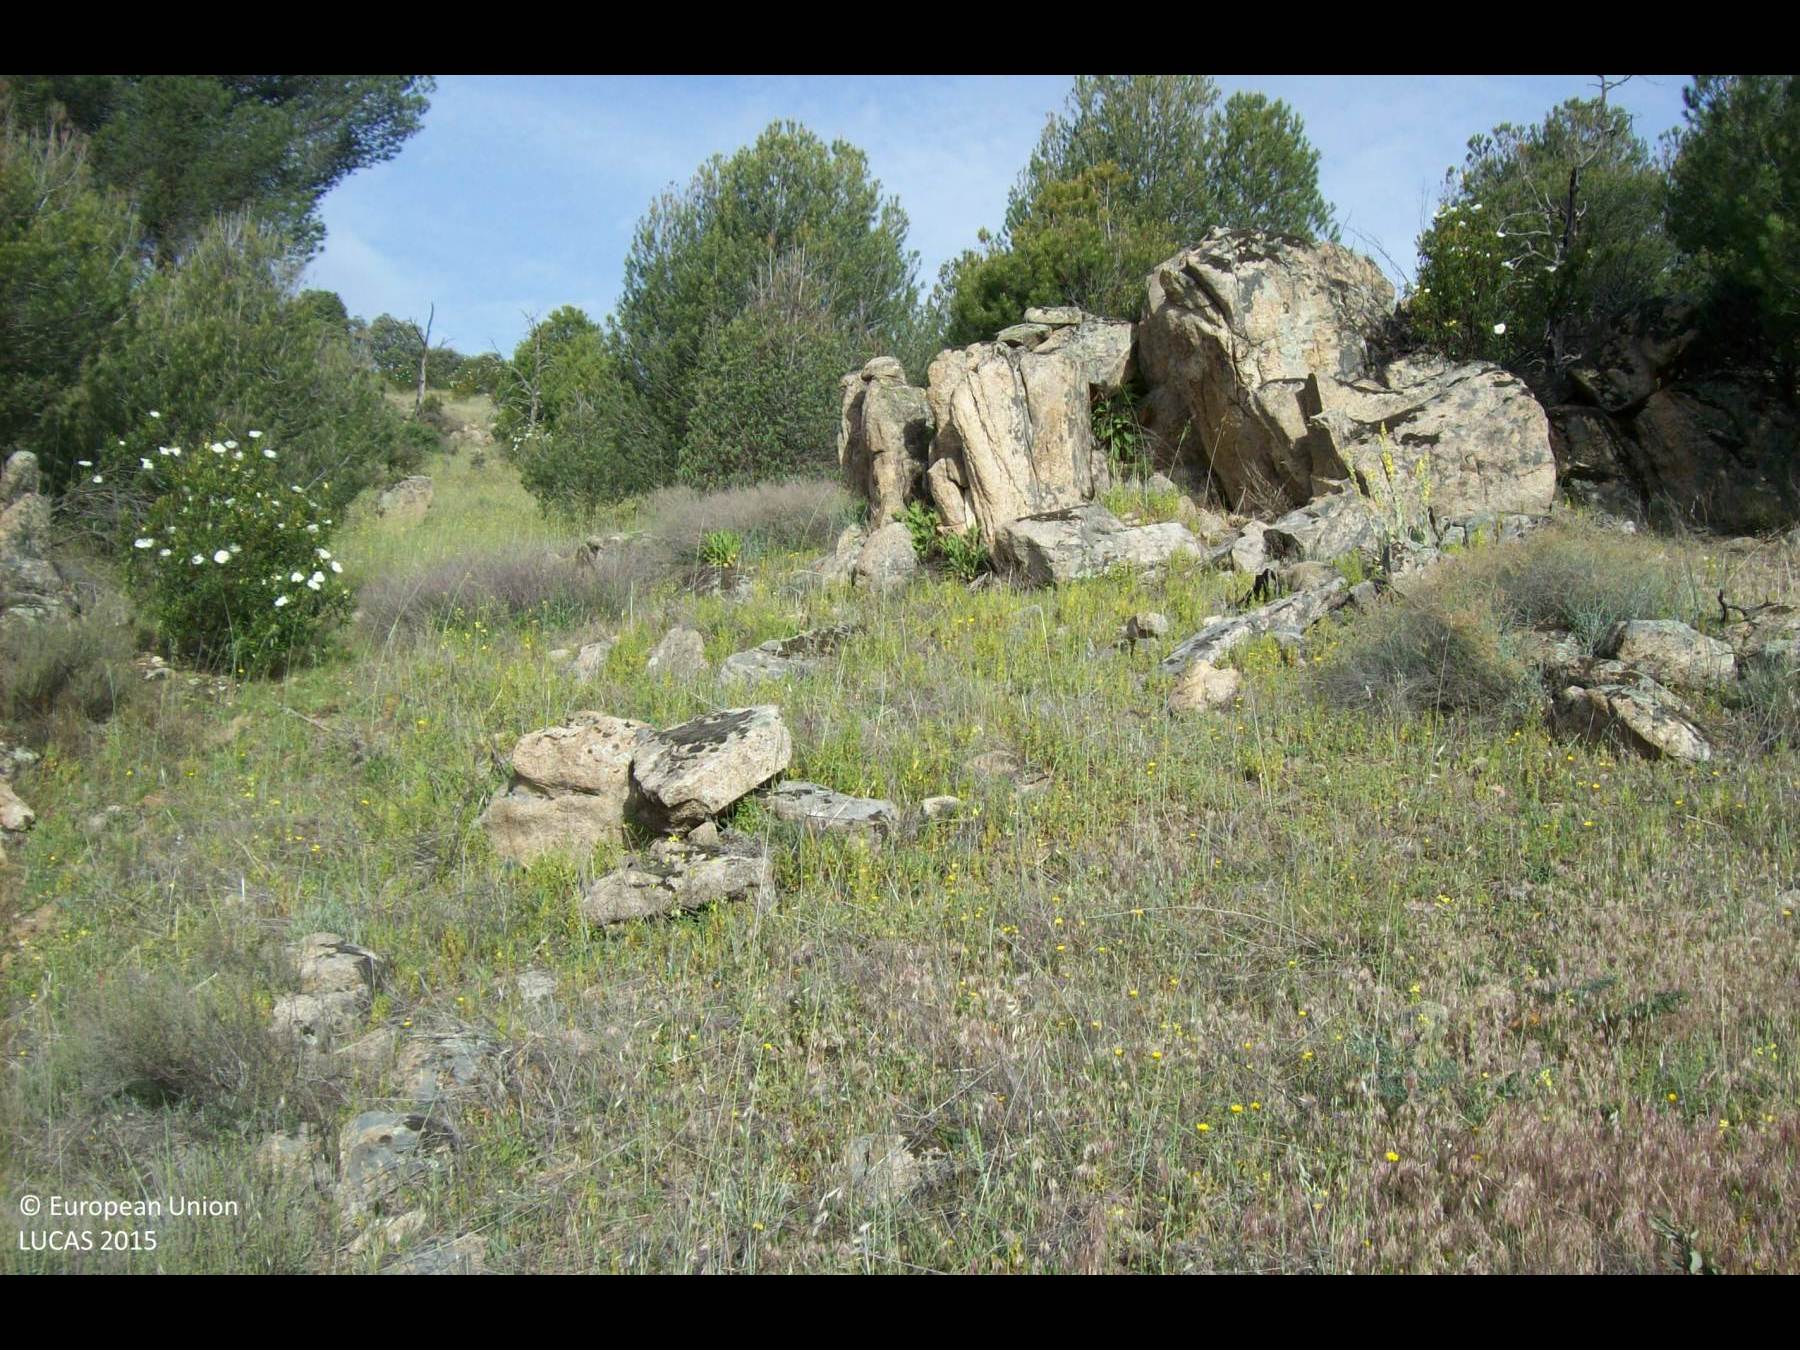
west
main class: Grassland
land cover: Grassland with sparse tree/shrub cover
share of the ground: > 75 %
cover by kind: herbaceous plants 85 %, coniferous forest trees 5 %, shrubs 5 %, consolidated bare surface 5 %
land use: Semi-natural and natural areas not in use
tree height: < 5 m
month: April
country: ES
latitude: 40.5494
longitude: -3.9411
